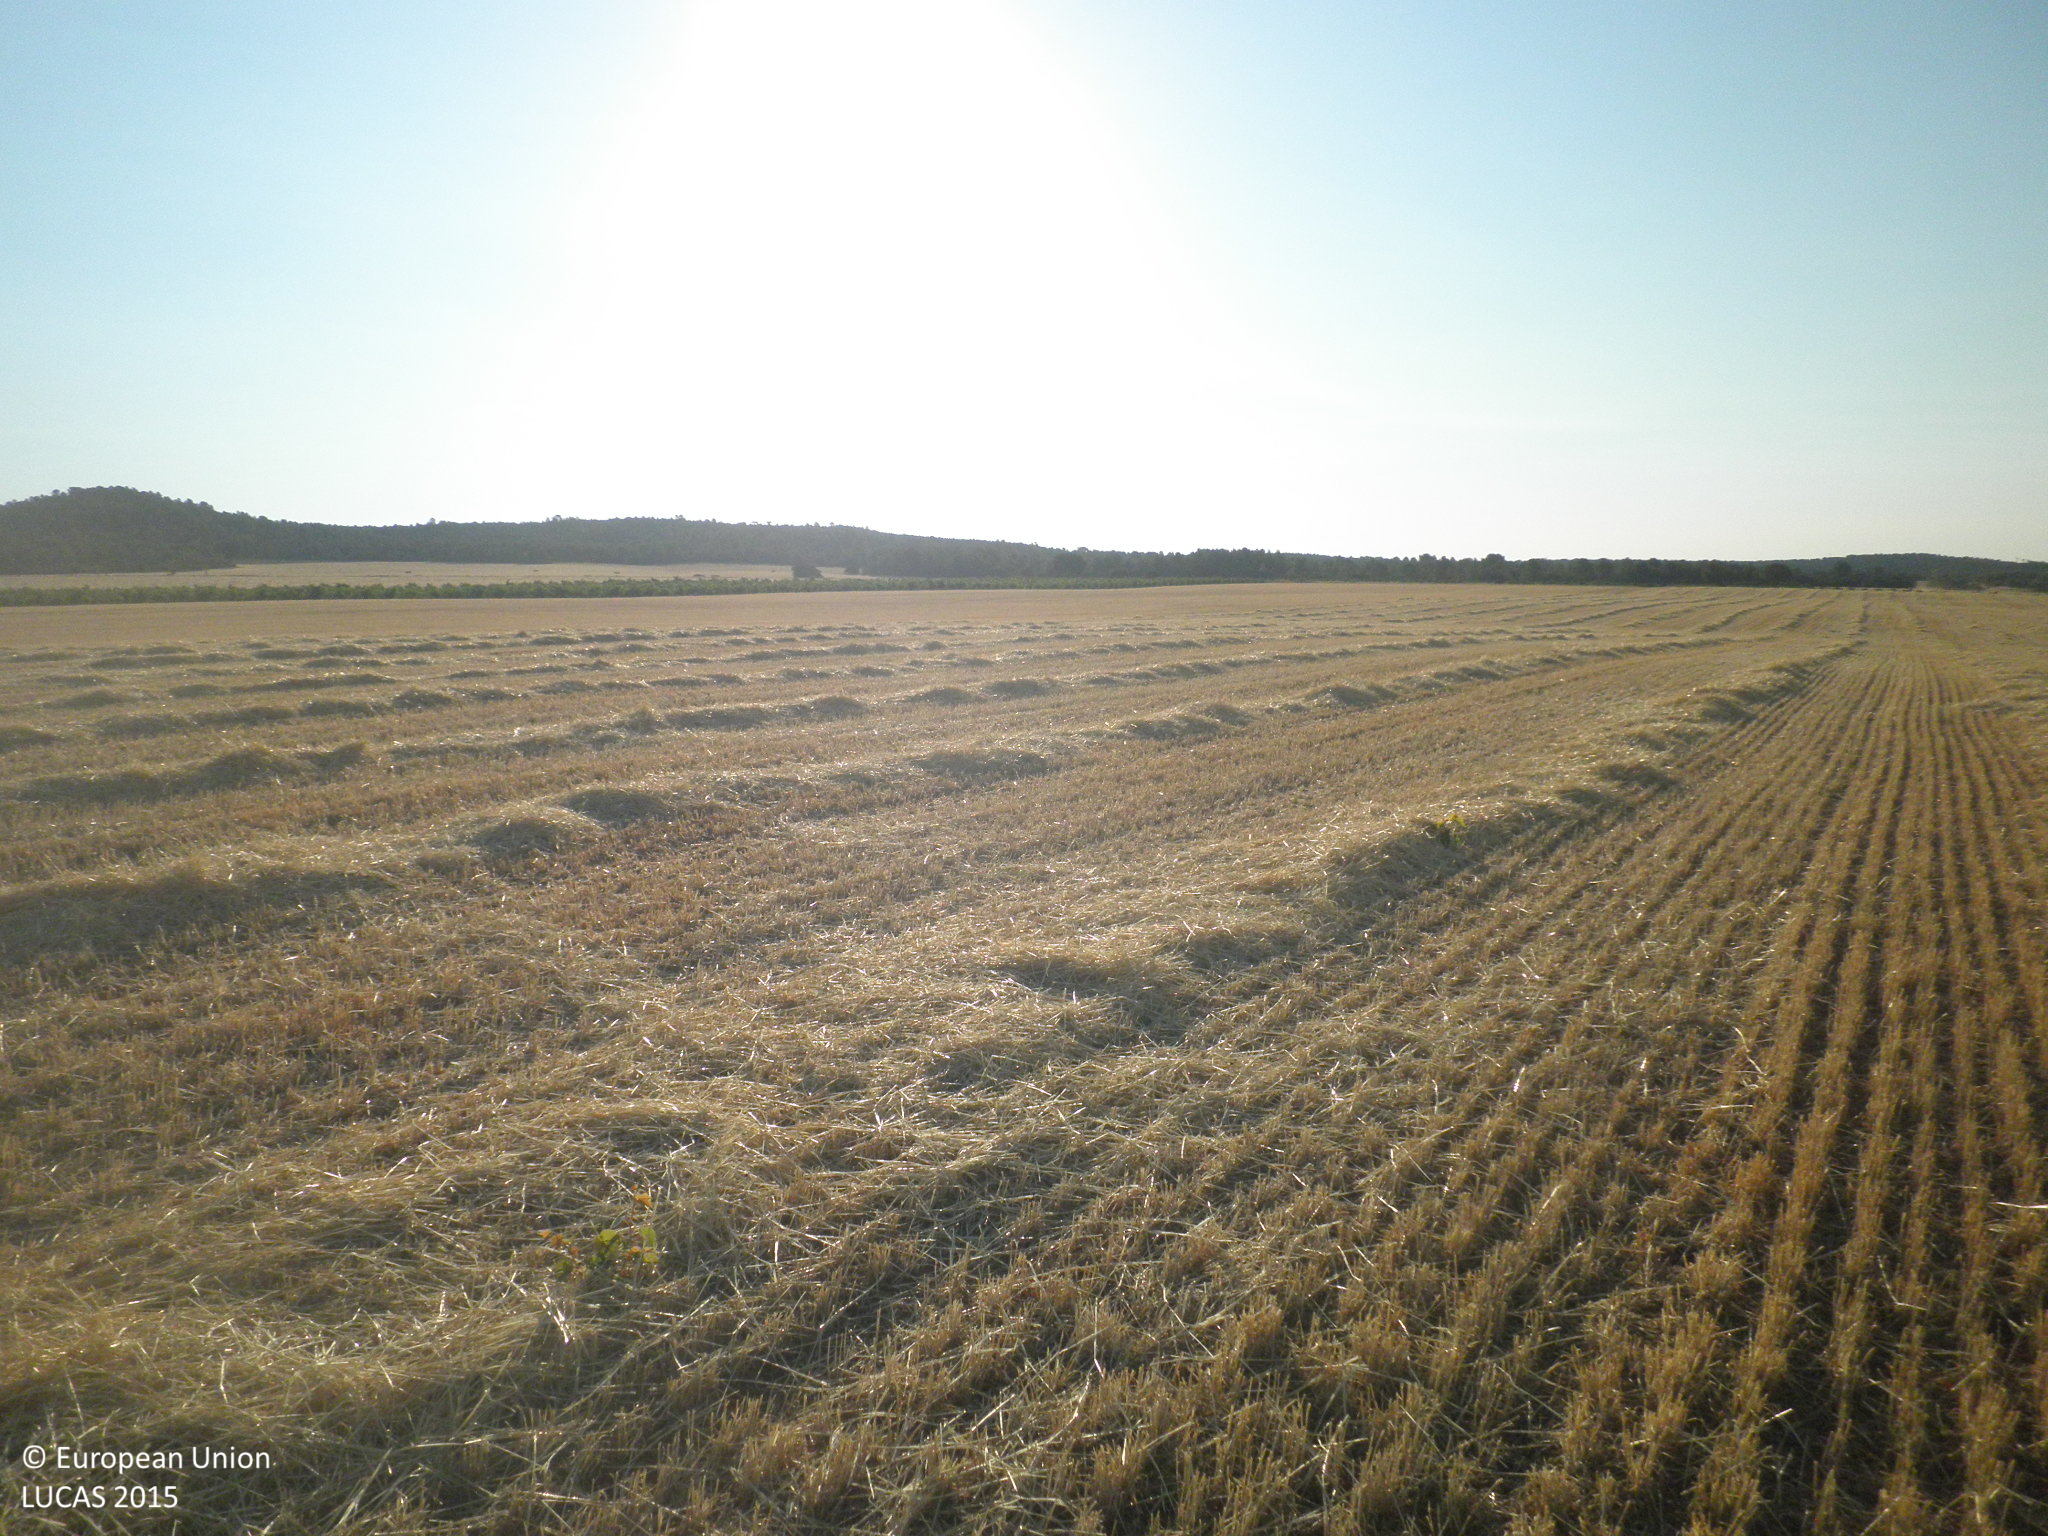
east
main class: Cropland
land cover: Barley
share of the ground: < 10 %
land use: Agriculture (excluding fallow land and kitchen gardens)
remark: Harvested field
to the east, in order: Barley
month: July
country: ES
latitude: 39.5475
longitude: -1.8418
